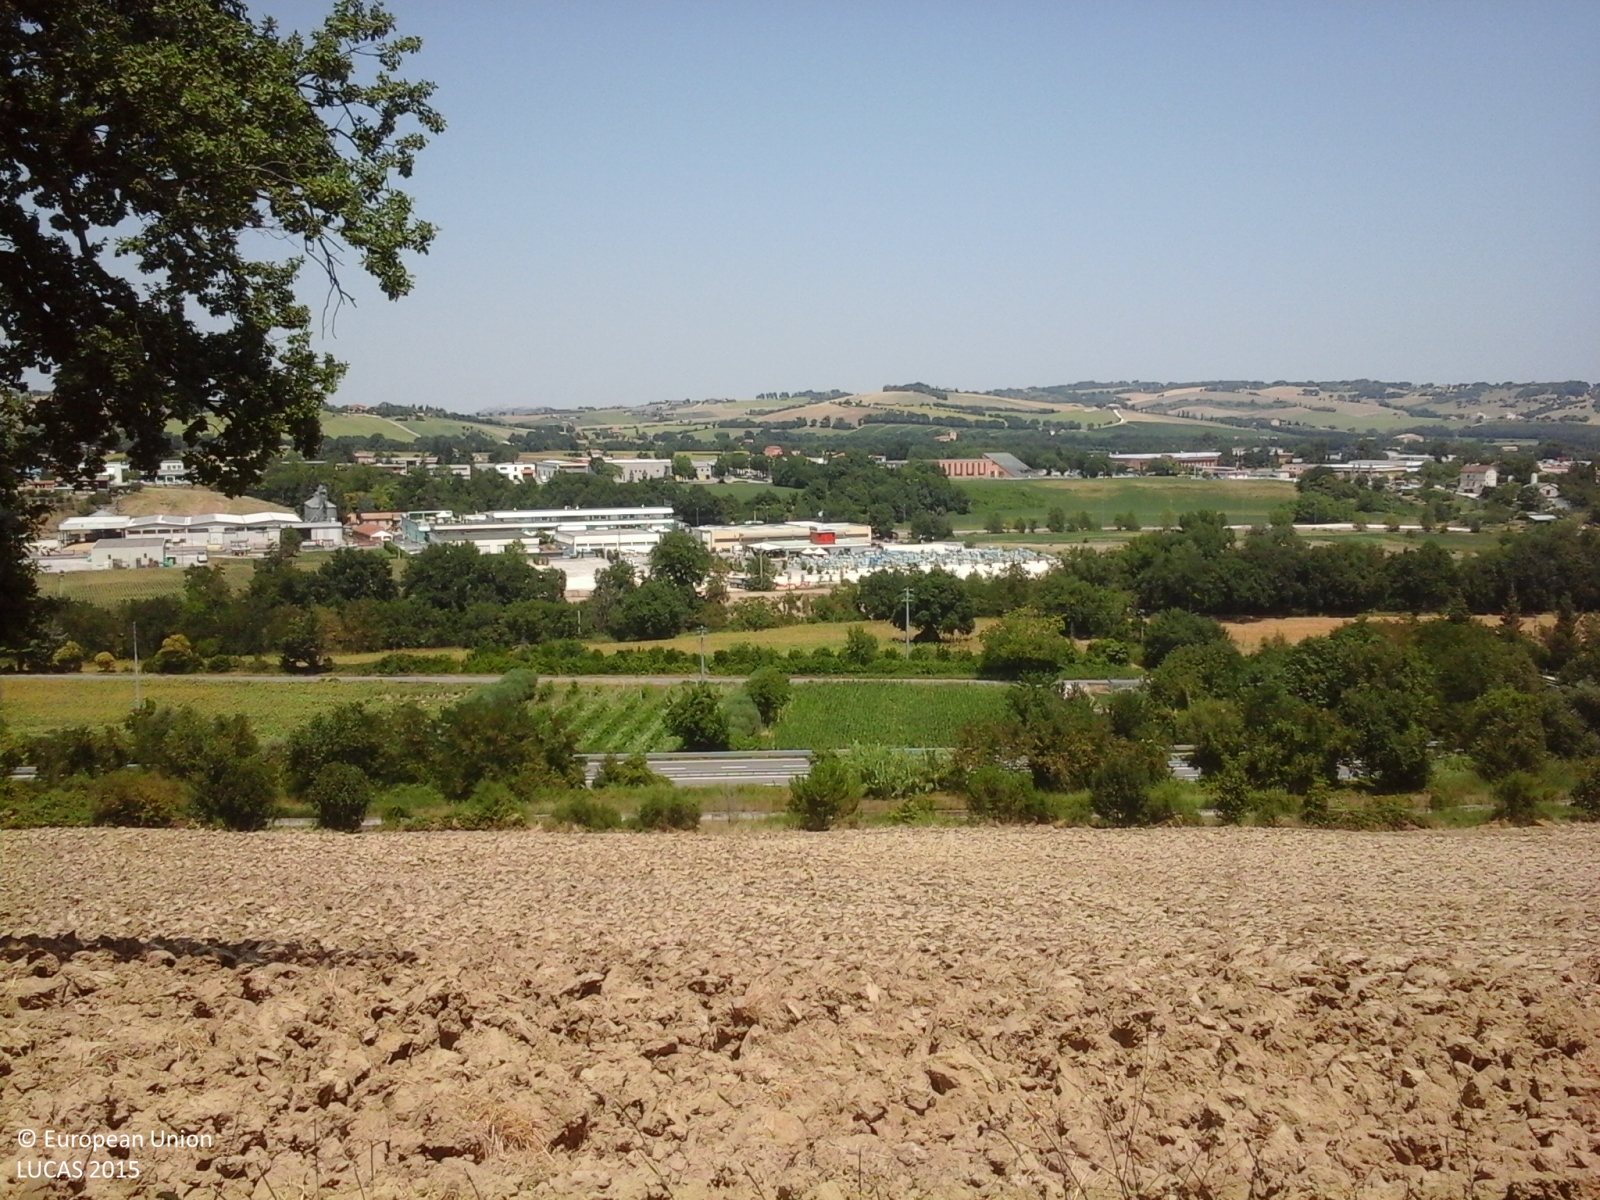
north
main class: Woodland
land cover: Broadleaved woodland
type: thermophilous deciduous forest
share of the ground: > 75 %
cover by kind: broadleaved forest trees 90 %, shrubs 5 %, herbaceous plants 5 %
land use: Forestry
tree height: > 5 m
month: July
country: IT
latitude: 43.2138
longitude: 13.3271
